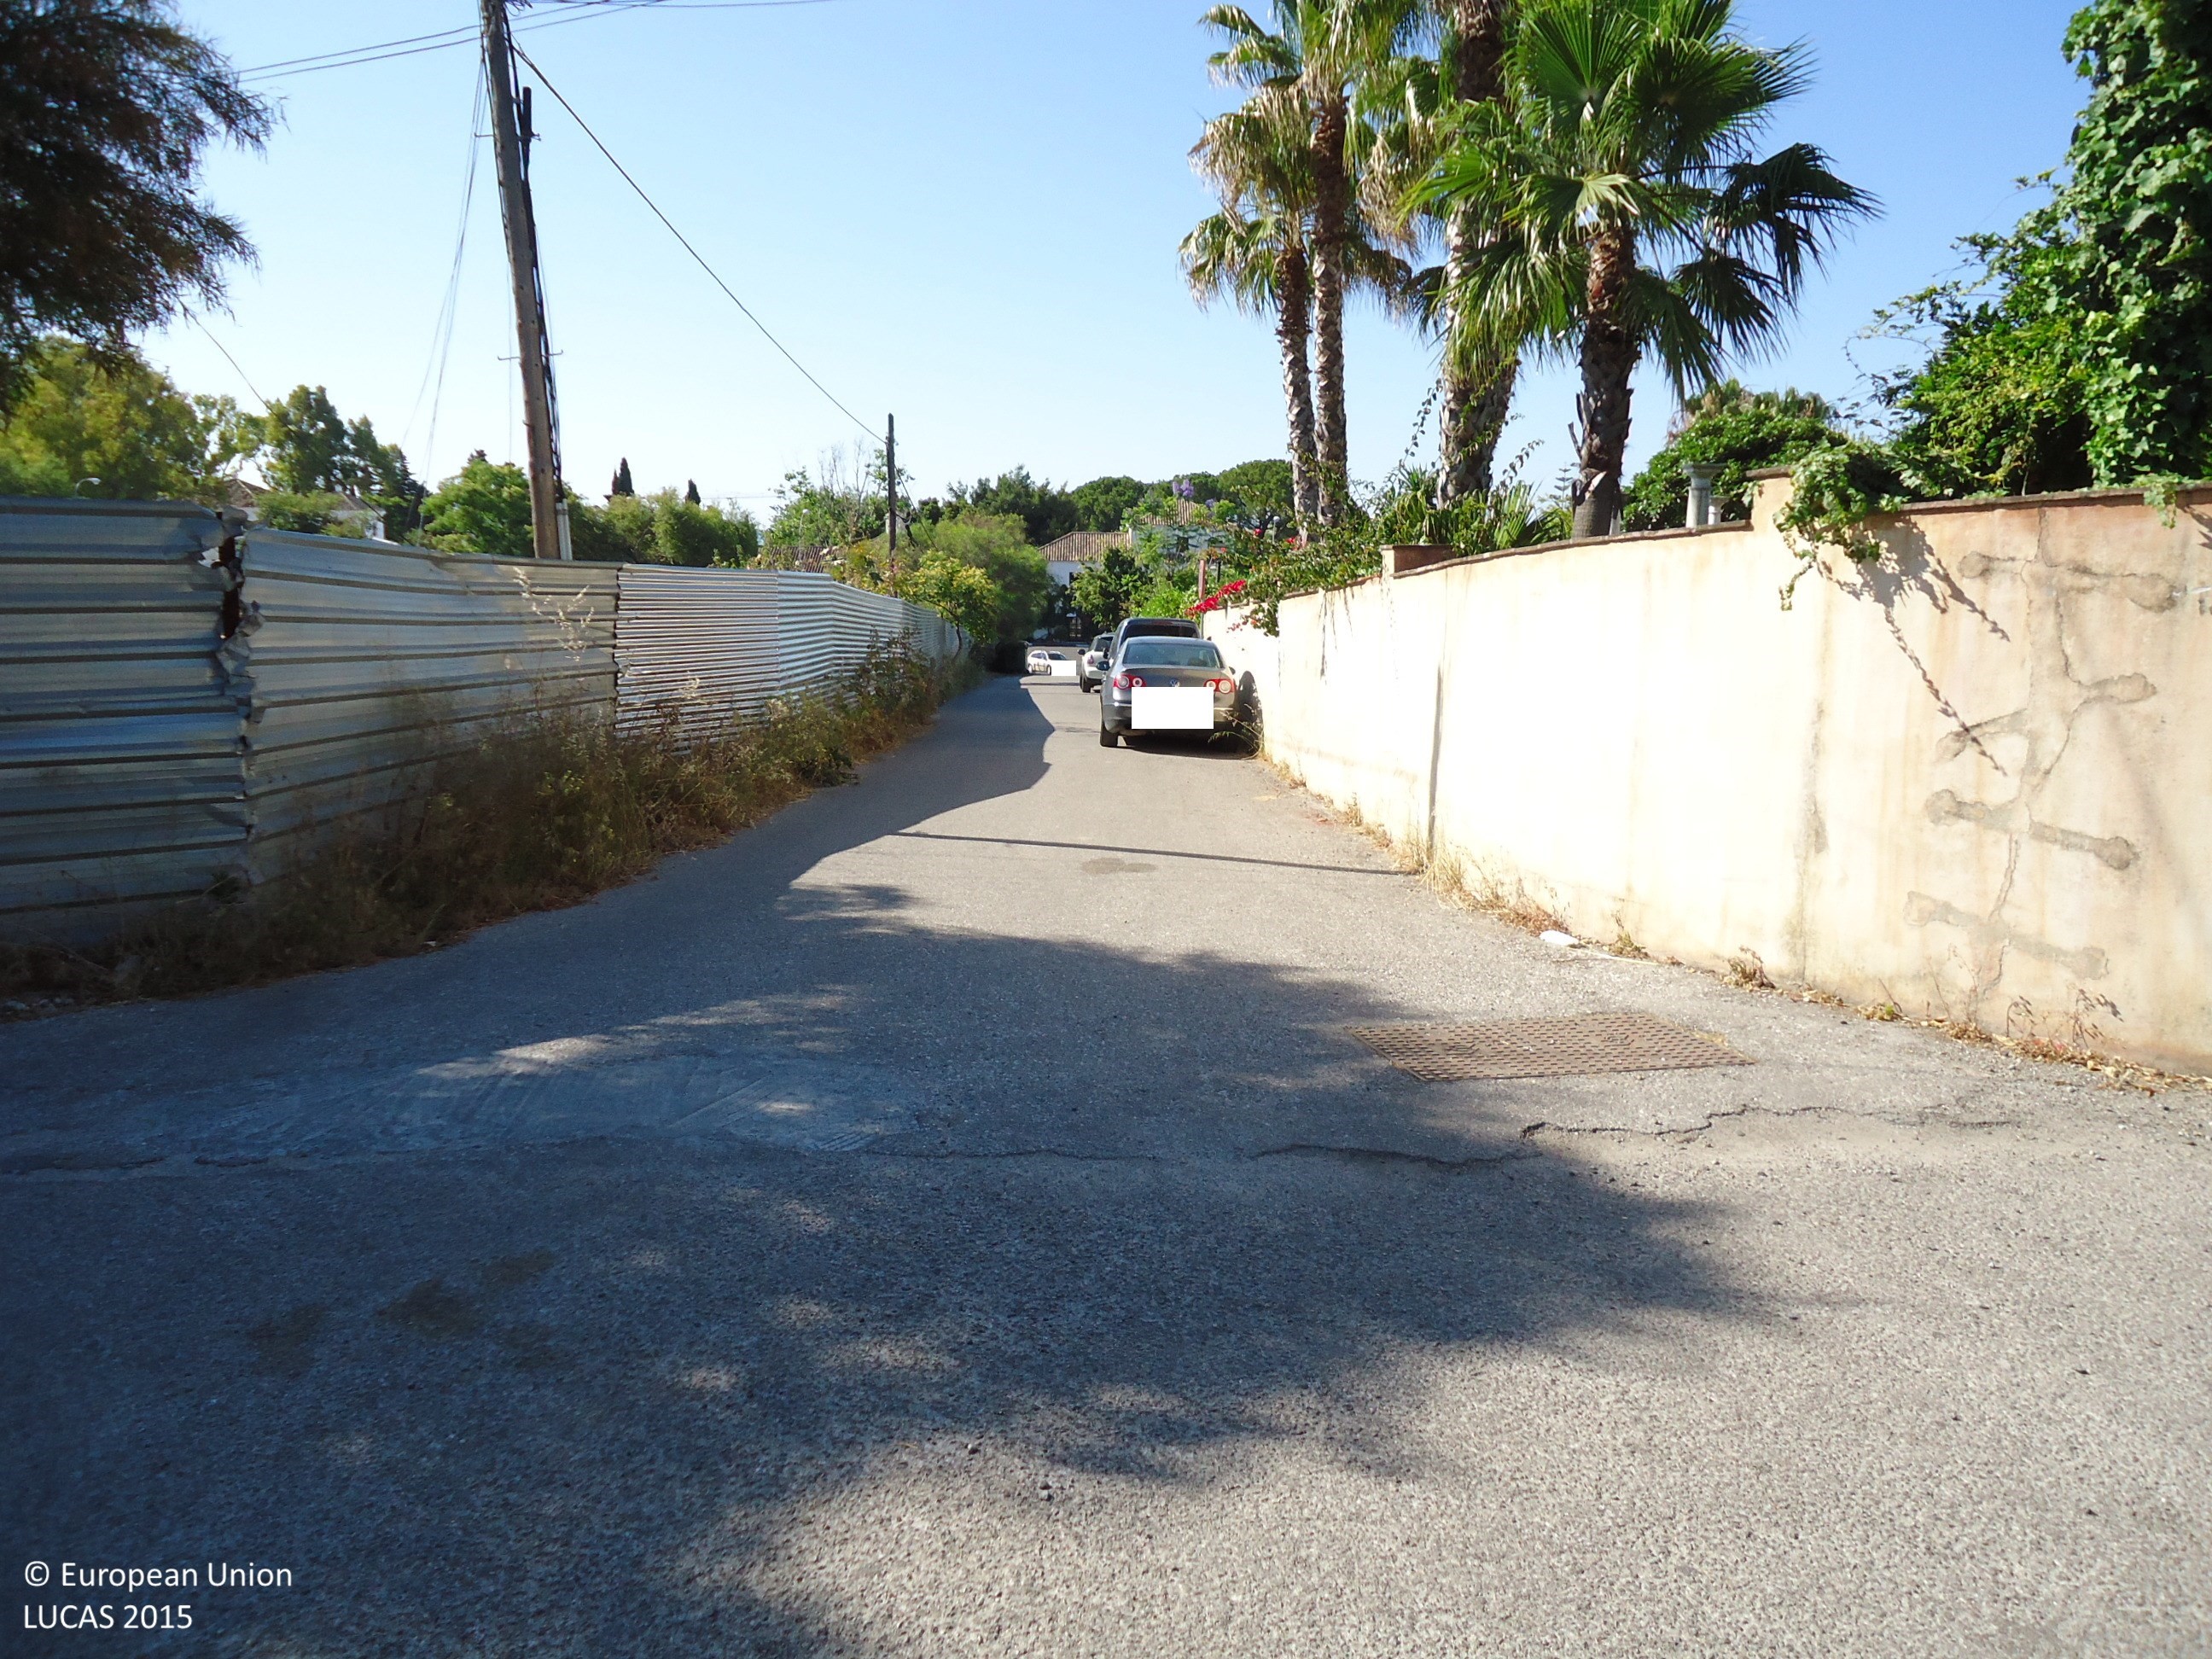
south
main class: Woodland
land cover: Broadleaved woodland
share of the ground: 25 - 50 %
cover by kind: herbaceous plants 70 %, broadleaved forest trees 30 %
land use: Residential
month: June
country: ES
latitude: 36.5081
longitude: -4.9200
